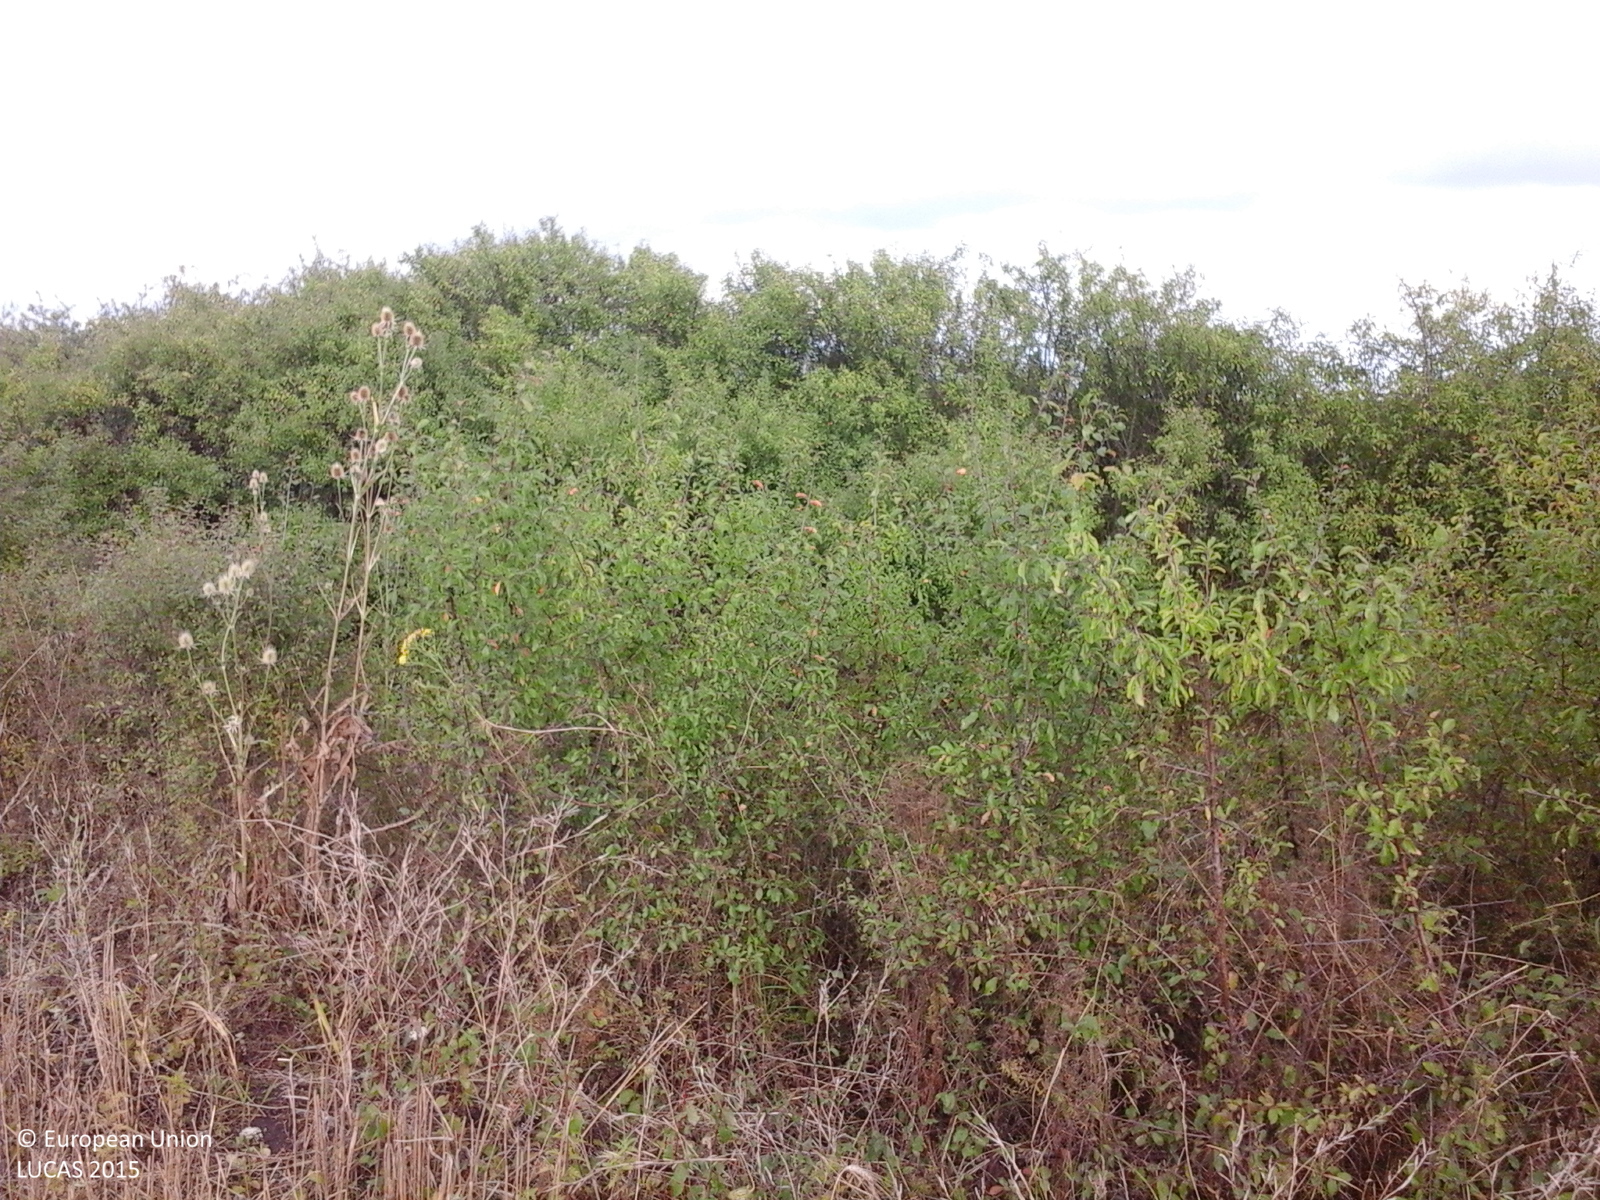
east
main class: Cropland
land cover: Common wheat
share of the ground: 50 - 75 %
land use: Agriculture (excluding fallow land and kitchen gardens)
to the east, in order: Common wheat; Lines of trees; Ditches and canals; Lines of trees; Grass margins; Tracks; Lucerne; Grass margins; Tracks; Grass margins; Common wheat
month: August
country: RO
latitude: 45.7977
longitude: 21.3670
